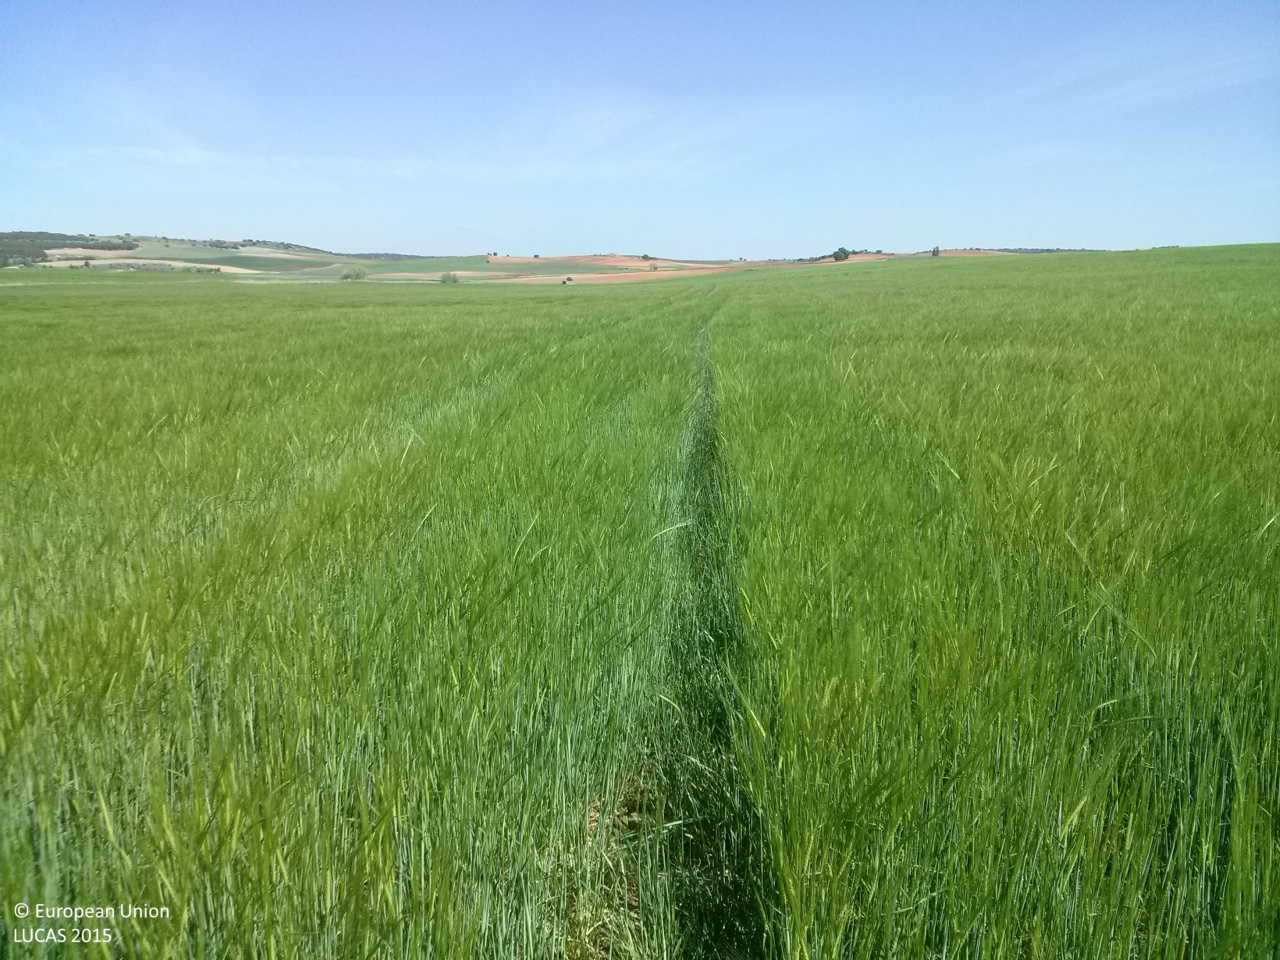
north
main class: Cropland
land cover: Barley
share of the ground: > 75 %
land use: Agriculture (excluding fallow land and kitchen gardens)
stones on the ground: < 10 %
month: May
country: ES
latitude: 39.8259
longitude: -2.8130
